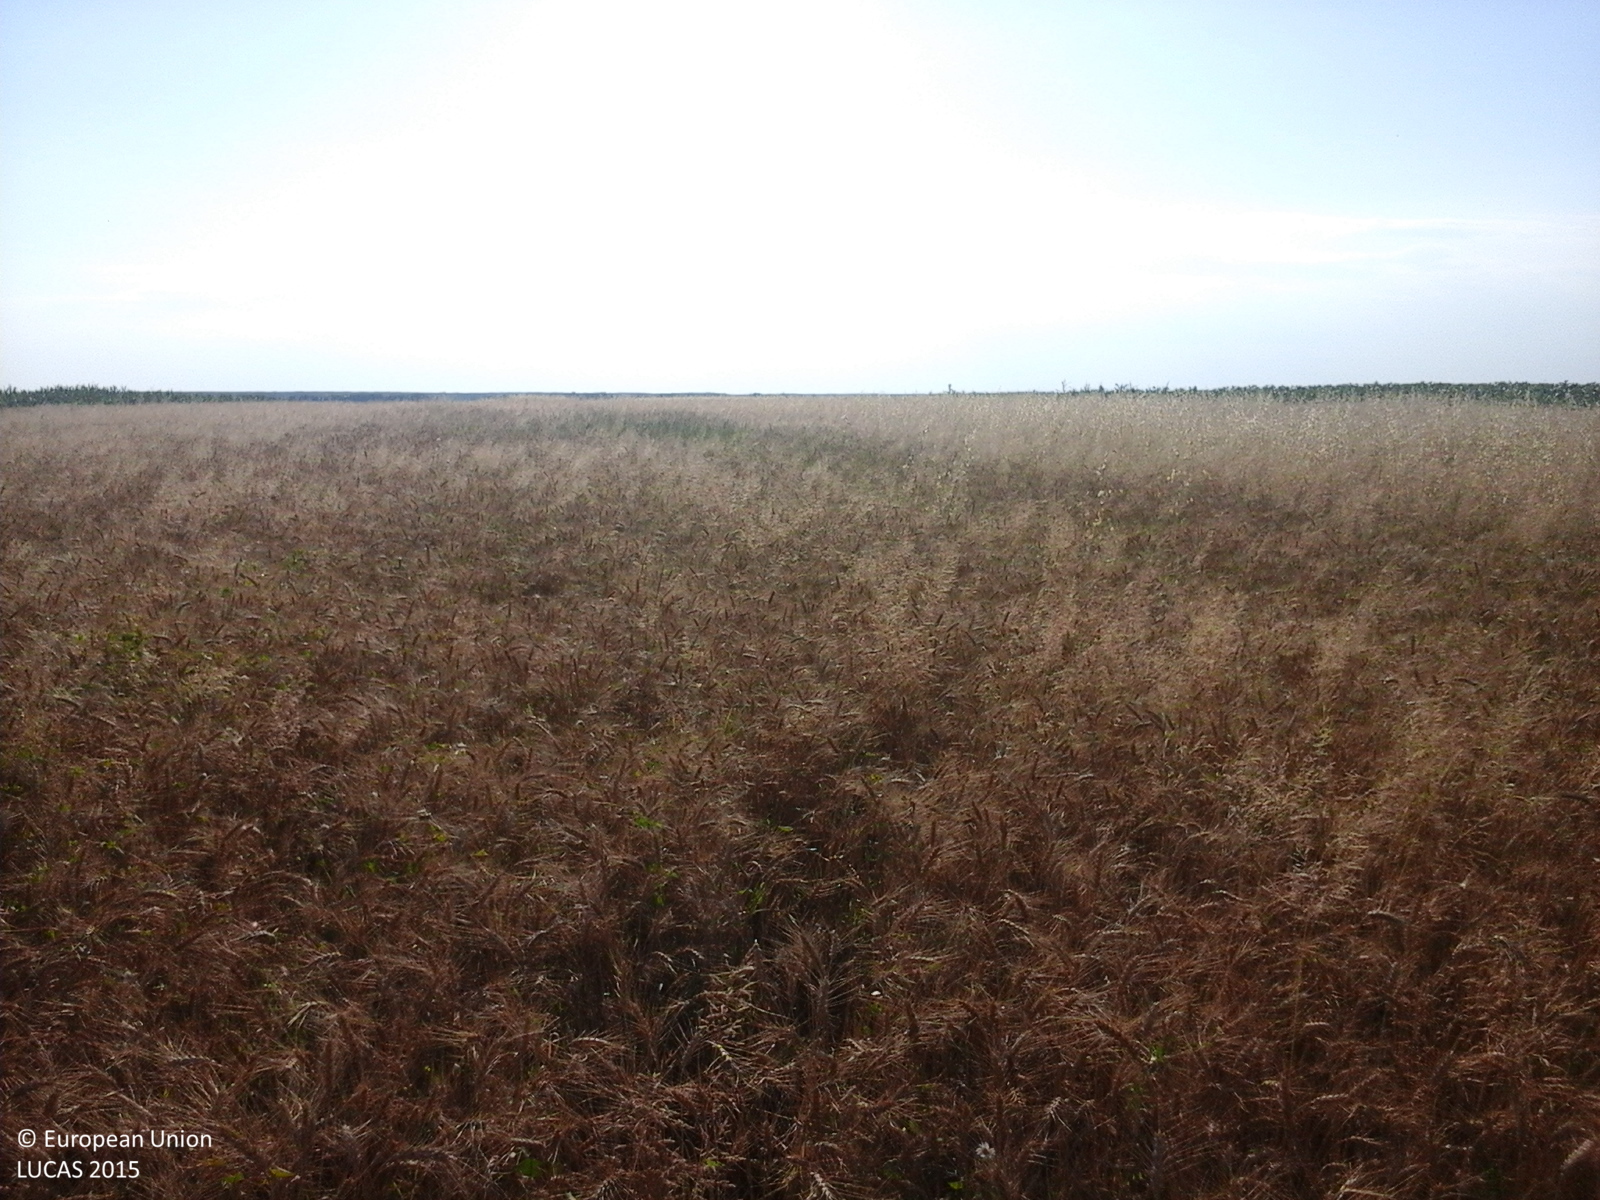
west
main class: Cropland
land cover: Common wheat
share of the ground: > 75 %
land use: Agriculture (excluding fallow land and kitchen gardens)
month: July
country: RO
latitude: 44.5788
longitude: 24.5687
